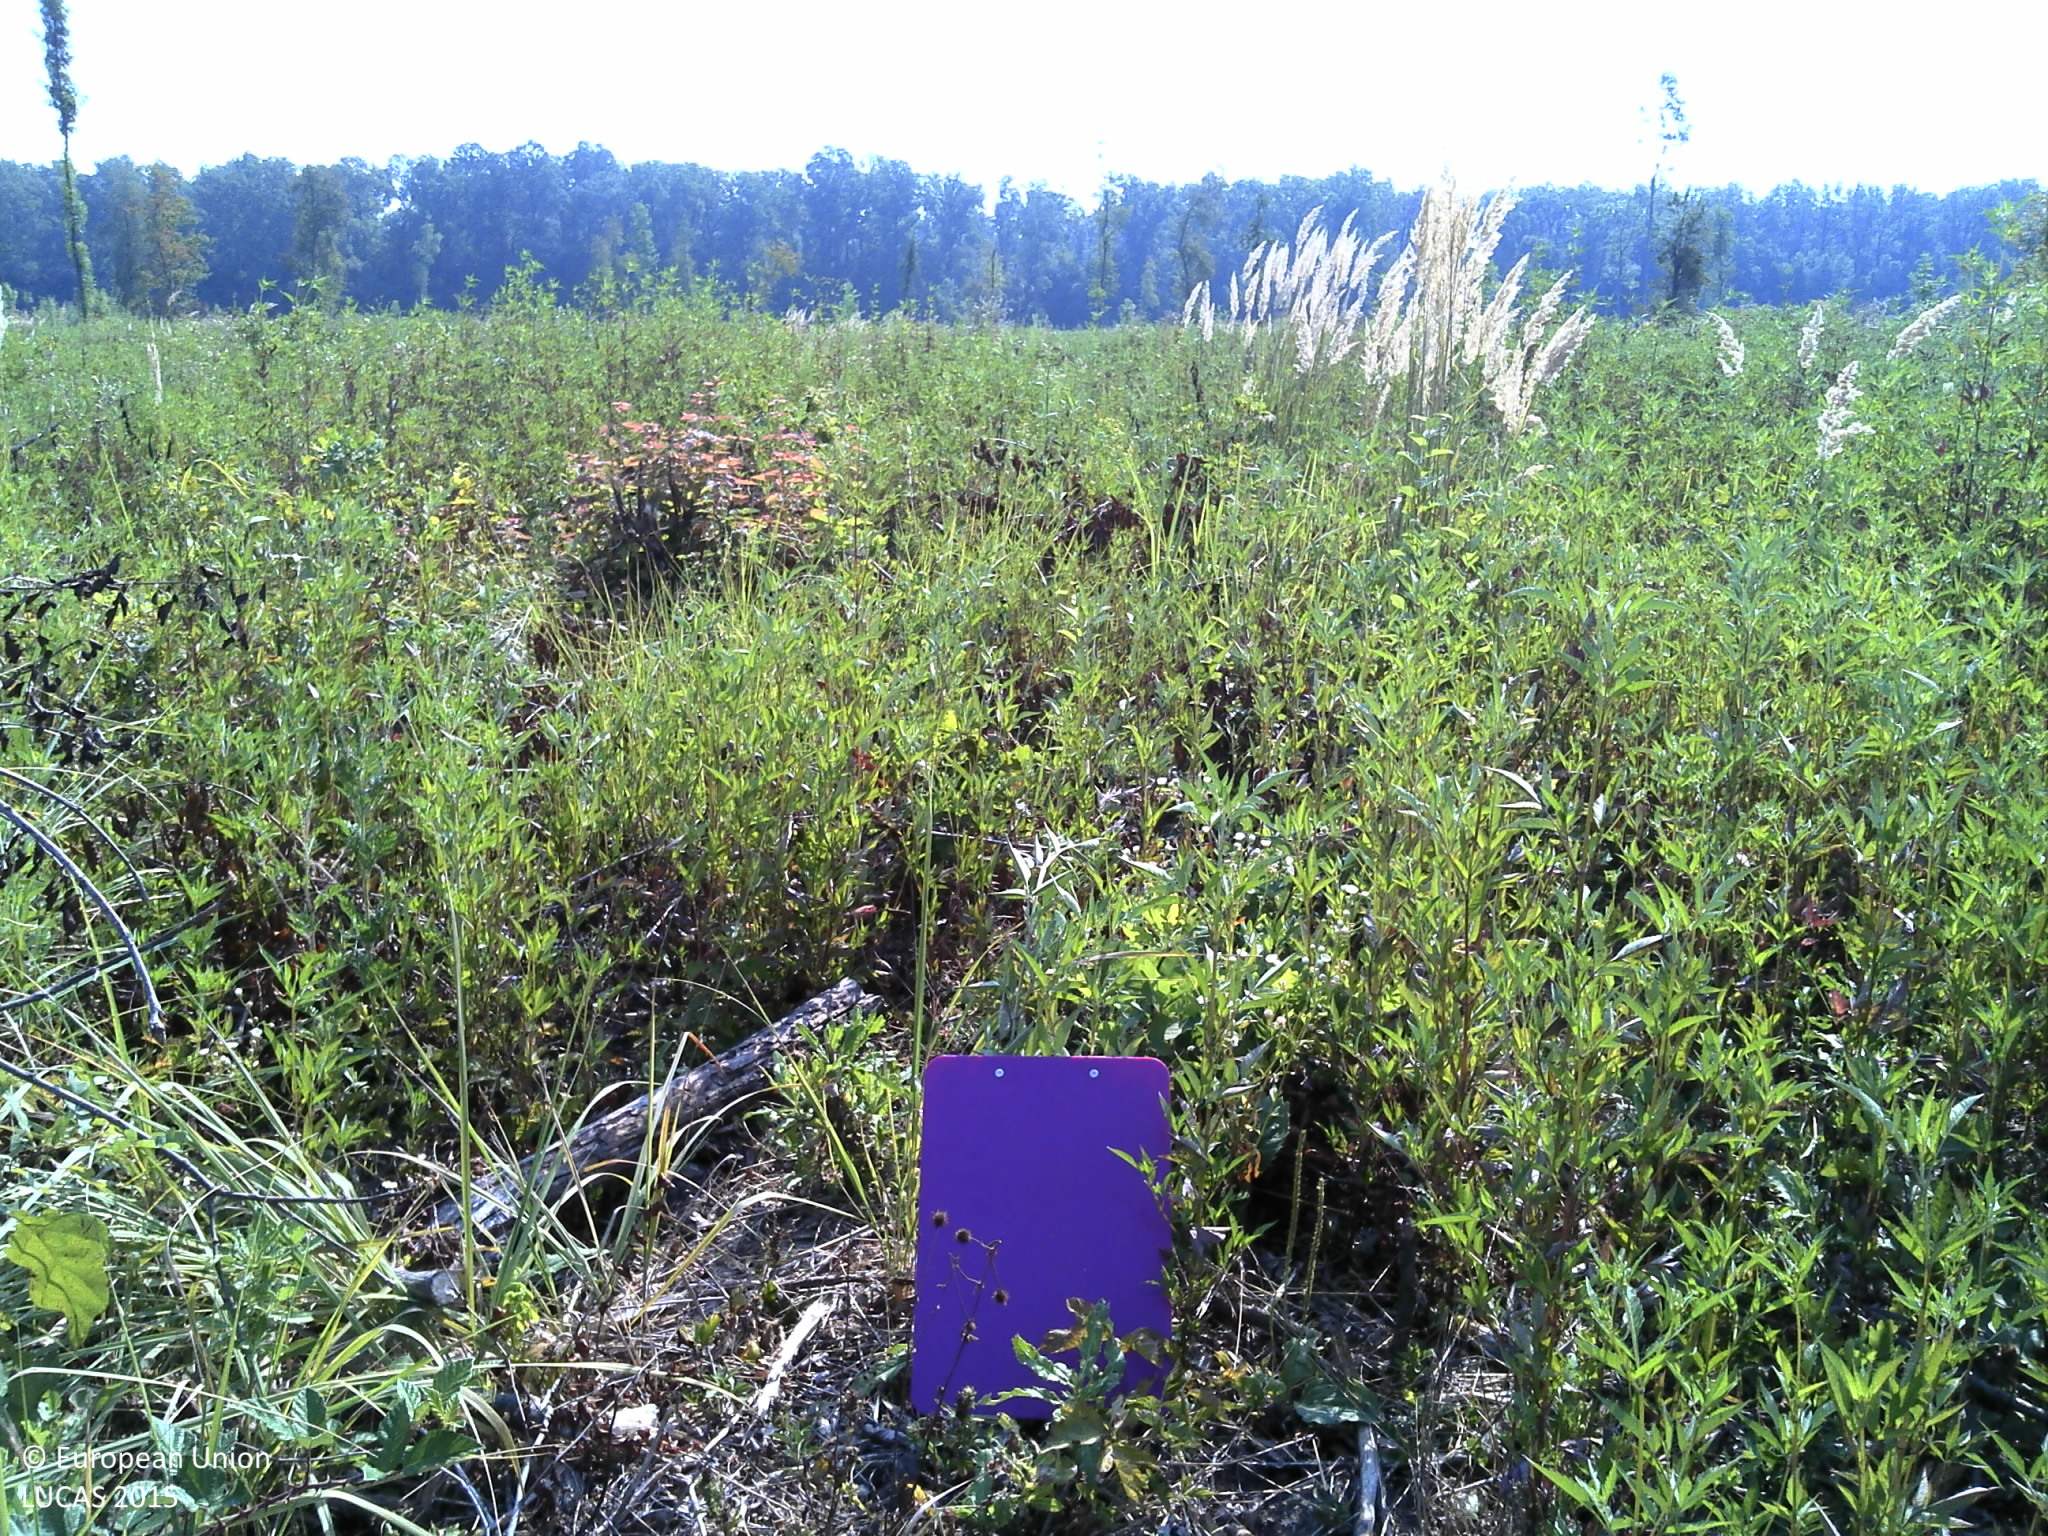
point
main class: Grassland
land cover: Spontaneously vegetated surfaces
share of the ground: > 75 %
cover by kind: herbaceous plants 100 %
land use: Semi-natural and natural areas not in use
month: August
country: HR
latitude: 45.0990
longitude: 18.8129
